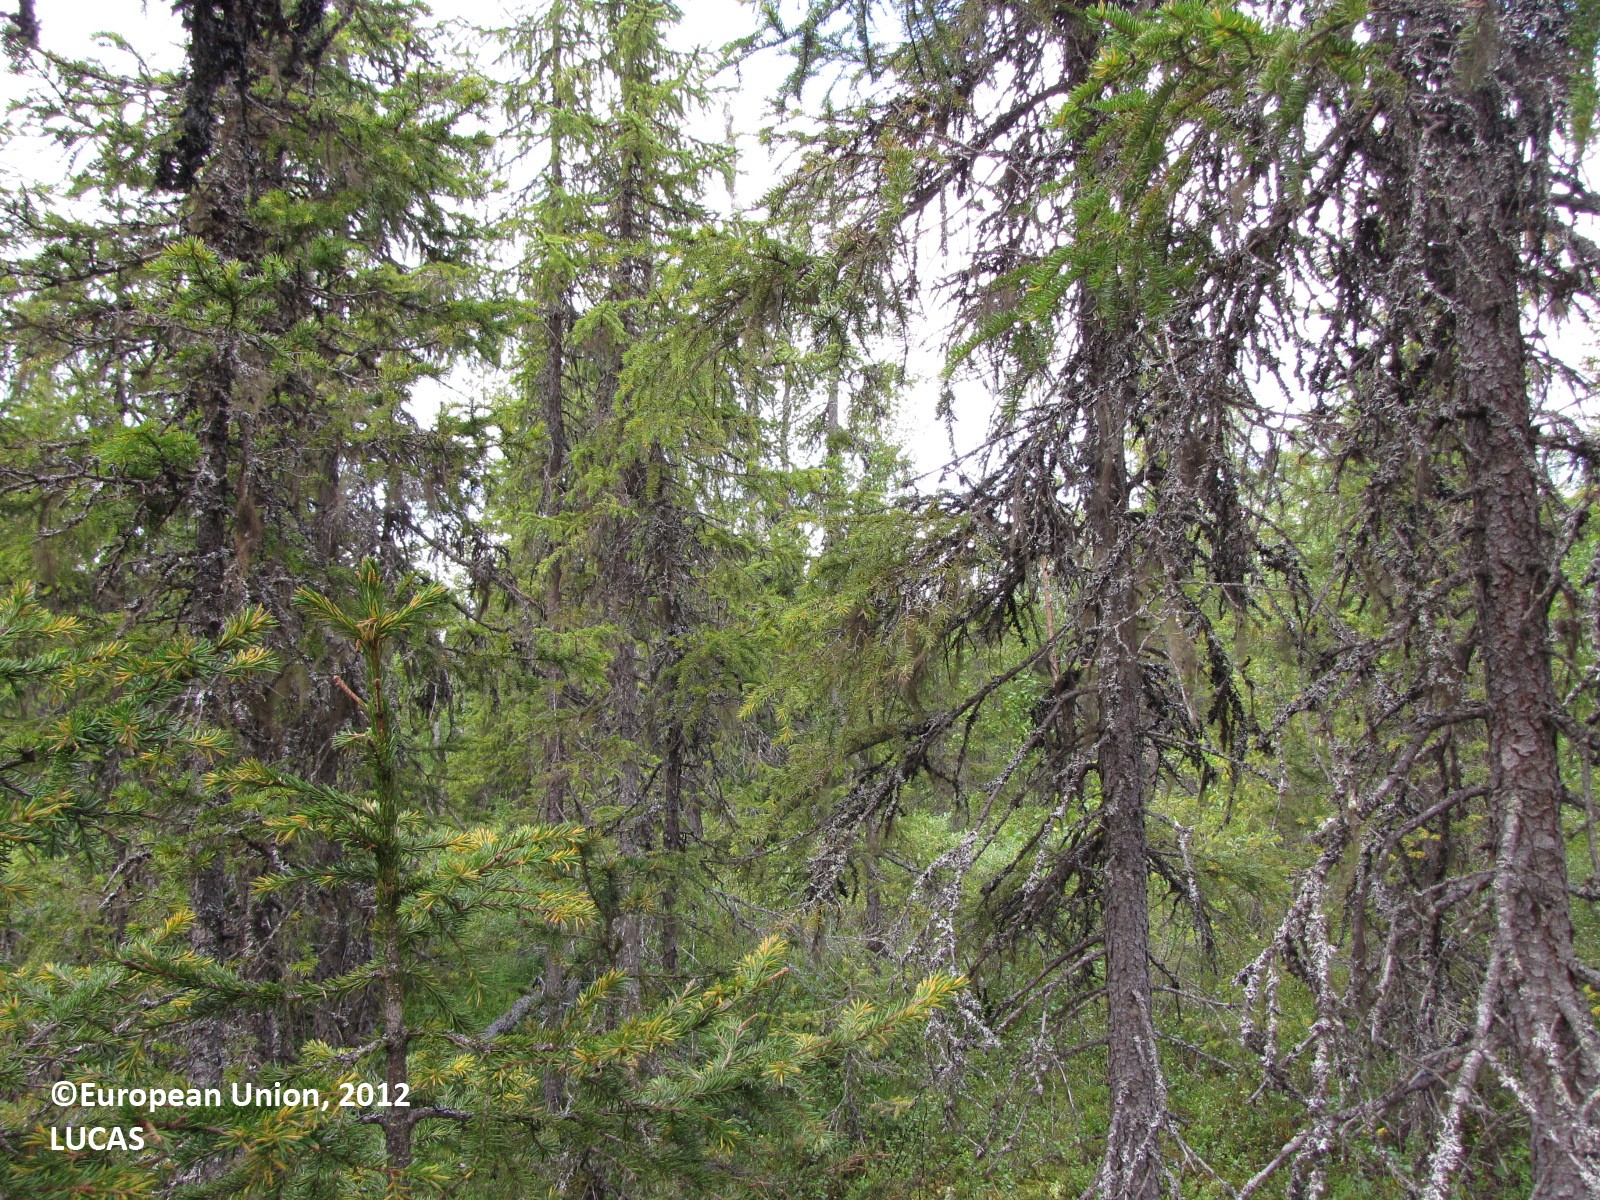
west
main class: Woodland
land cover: Spruce dominated coniferous woodland
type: boreal forest
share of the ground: 25 - 50 %
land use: Forestry
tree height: > 5 m
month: August
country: FI
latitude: 66.8599
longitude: 24.5667
